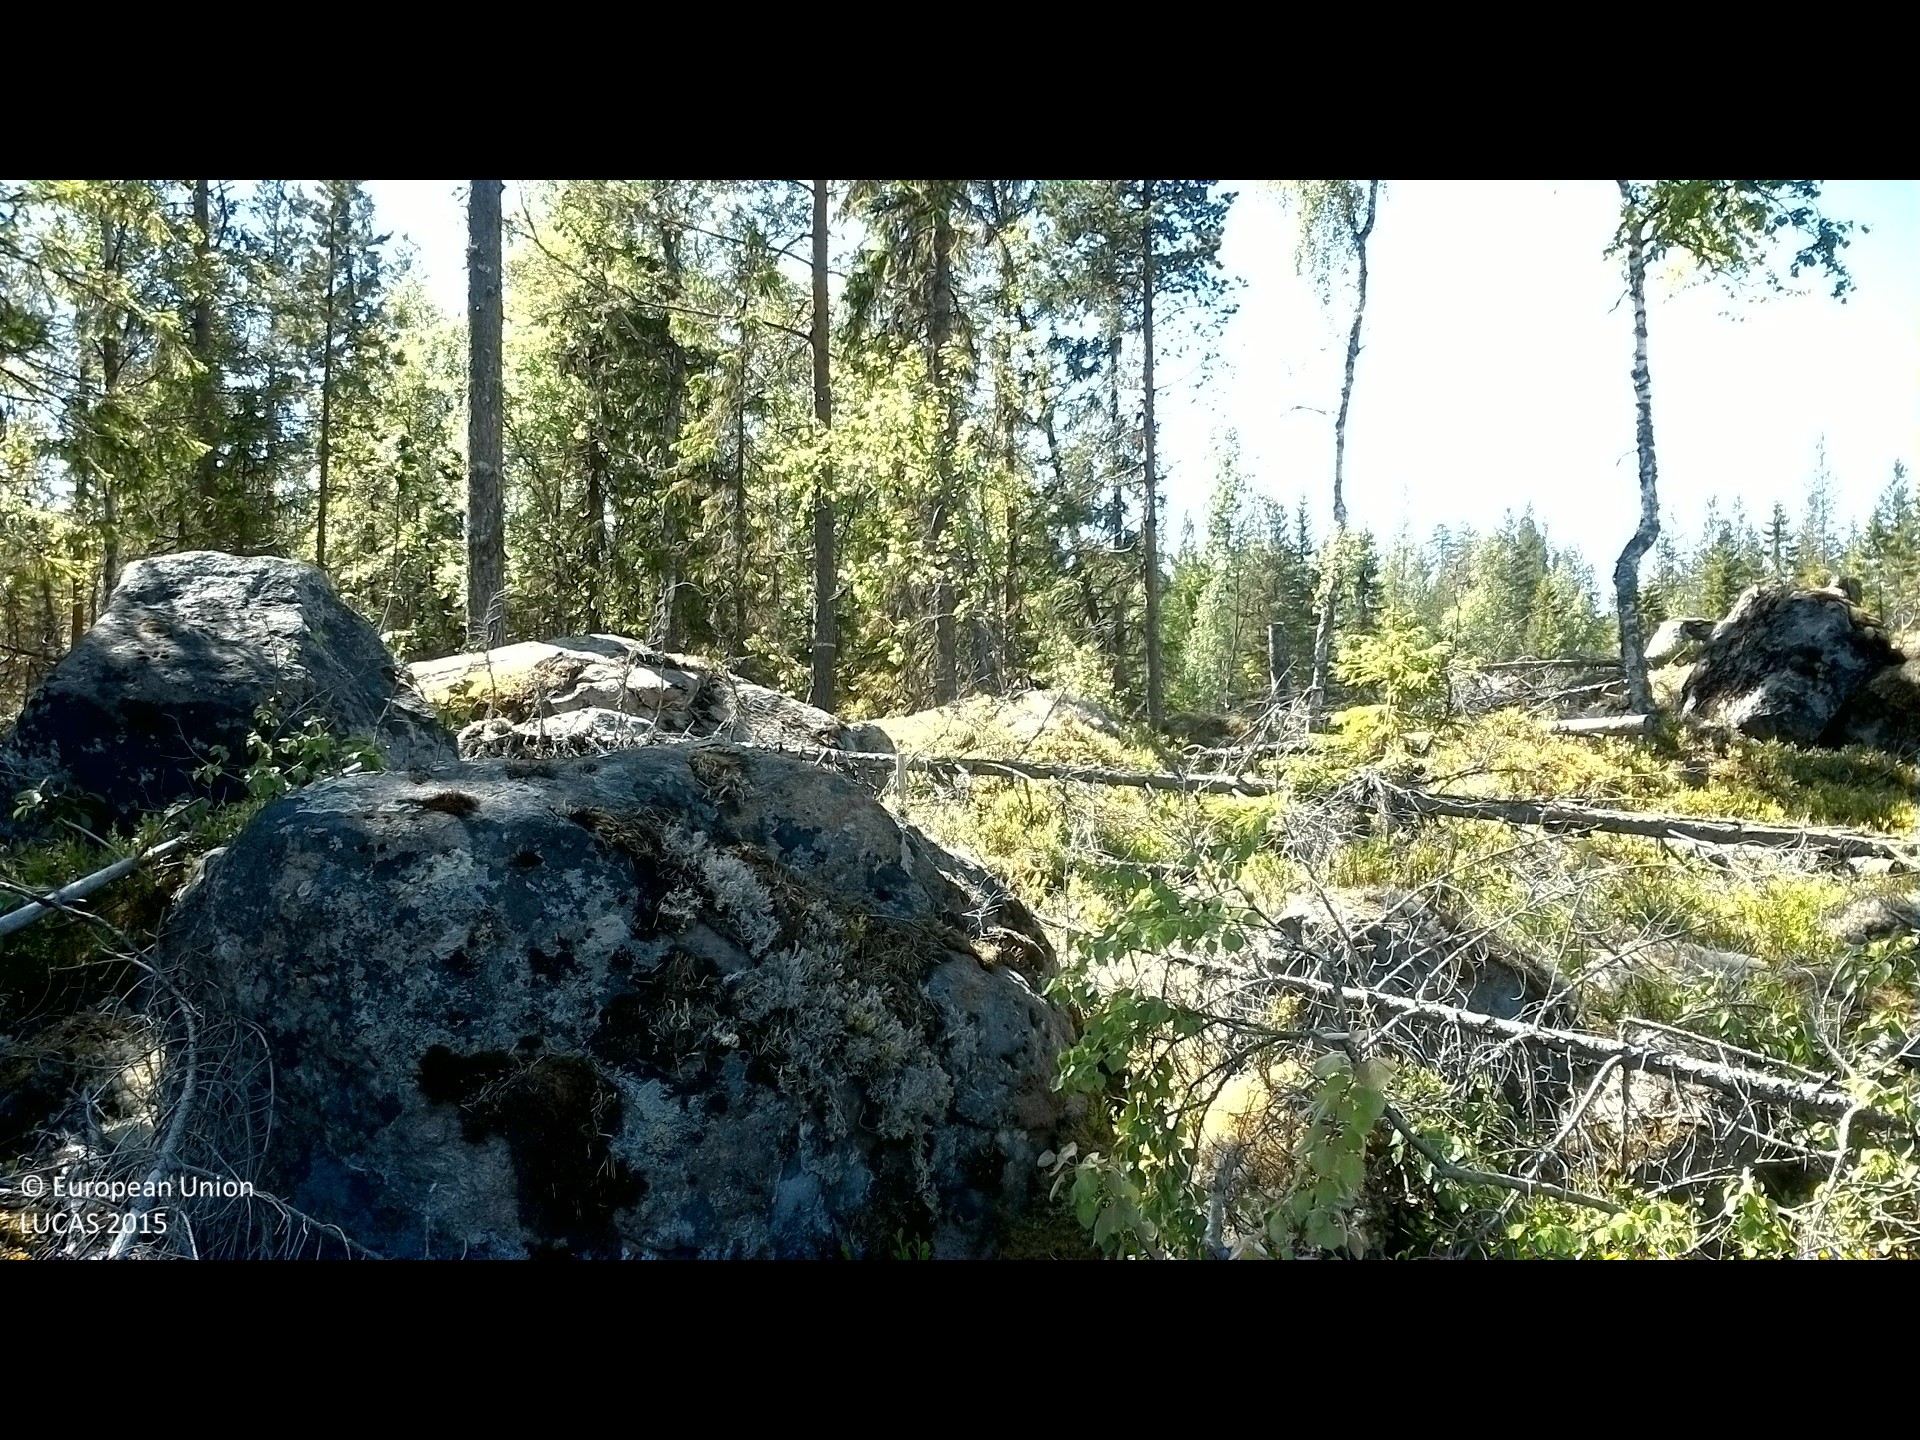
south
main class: Woodland
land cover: Spruce dominated coniferous woodland
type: boreal forest
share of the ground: 10 - 25 %
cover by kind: shrubs 55 %, coniferous forest trees 20 %, lichens and mosses 20 %, broadleaved forest trees 5 %
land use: Forestry
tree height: > 5 m
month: June
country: SE
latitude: 62.0148
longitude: 16.1900
